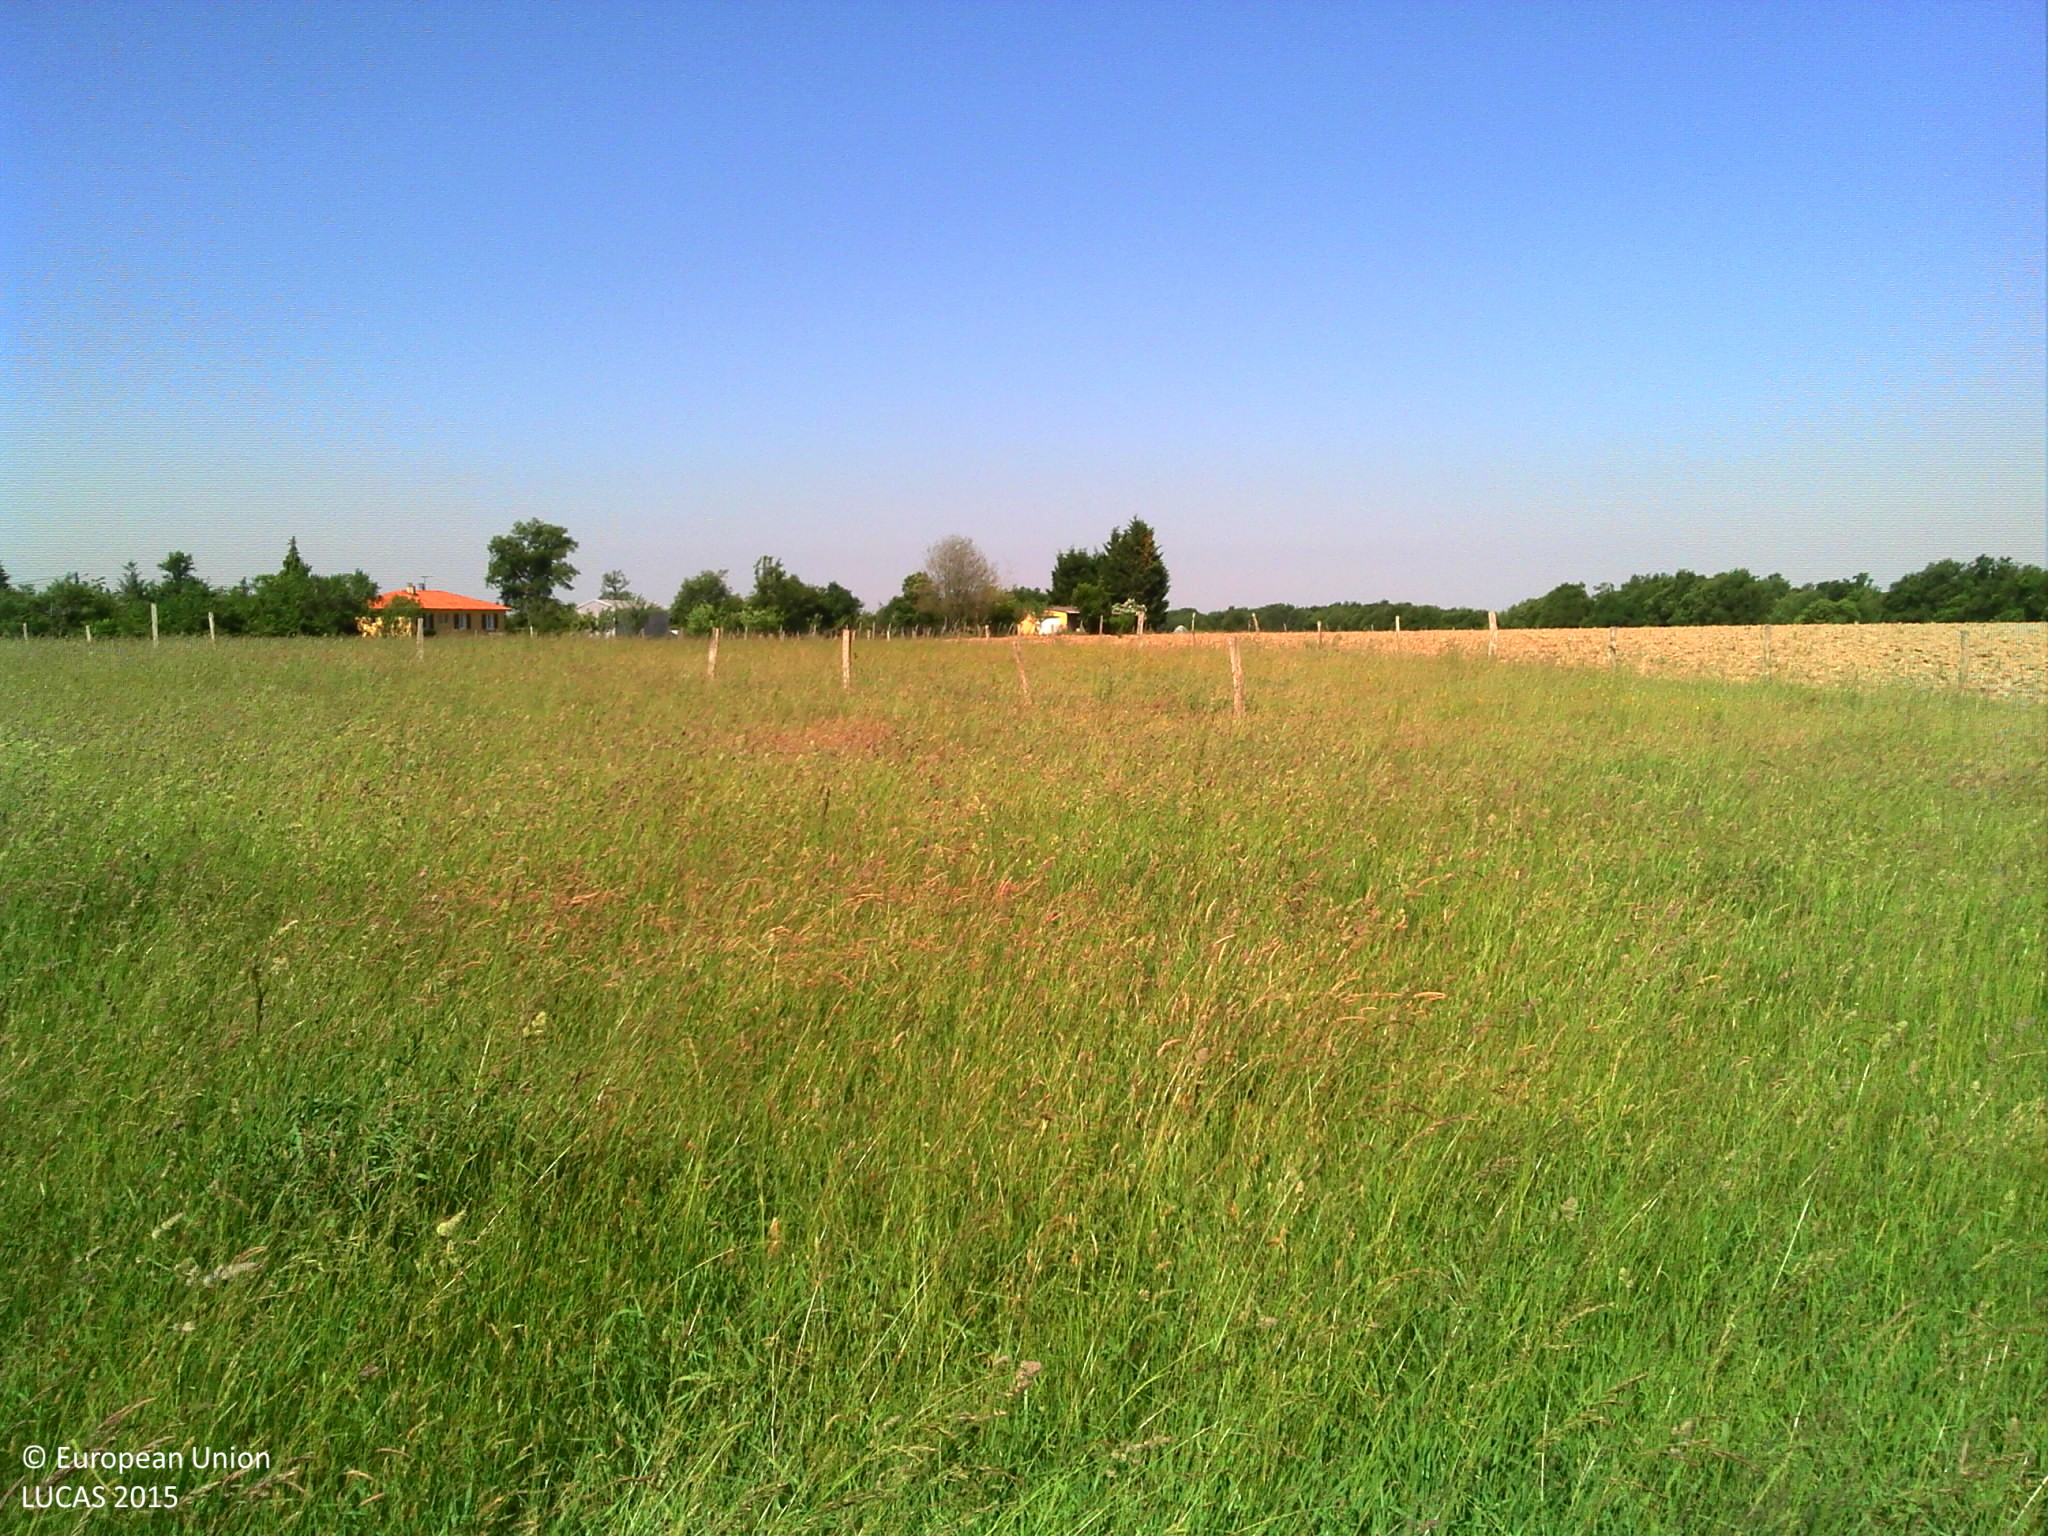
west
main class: Grassland
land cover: Grassland without tree/shrub cover
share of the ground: > 75 %
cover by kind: herbaceous plants 100 %
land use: Agriculture (excluding fallow land and kitchen gardens)
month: June
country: FR
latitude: 46.0466
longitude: 0.6160
